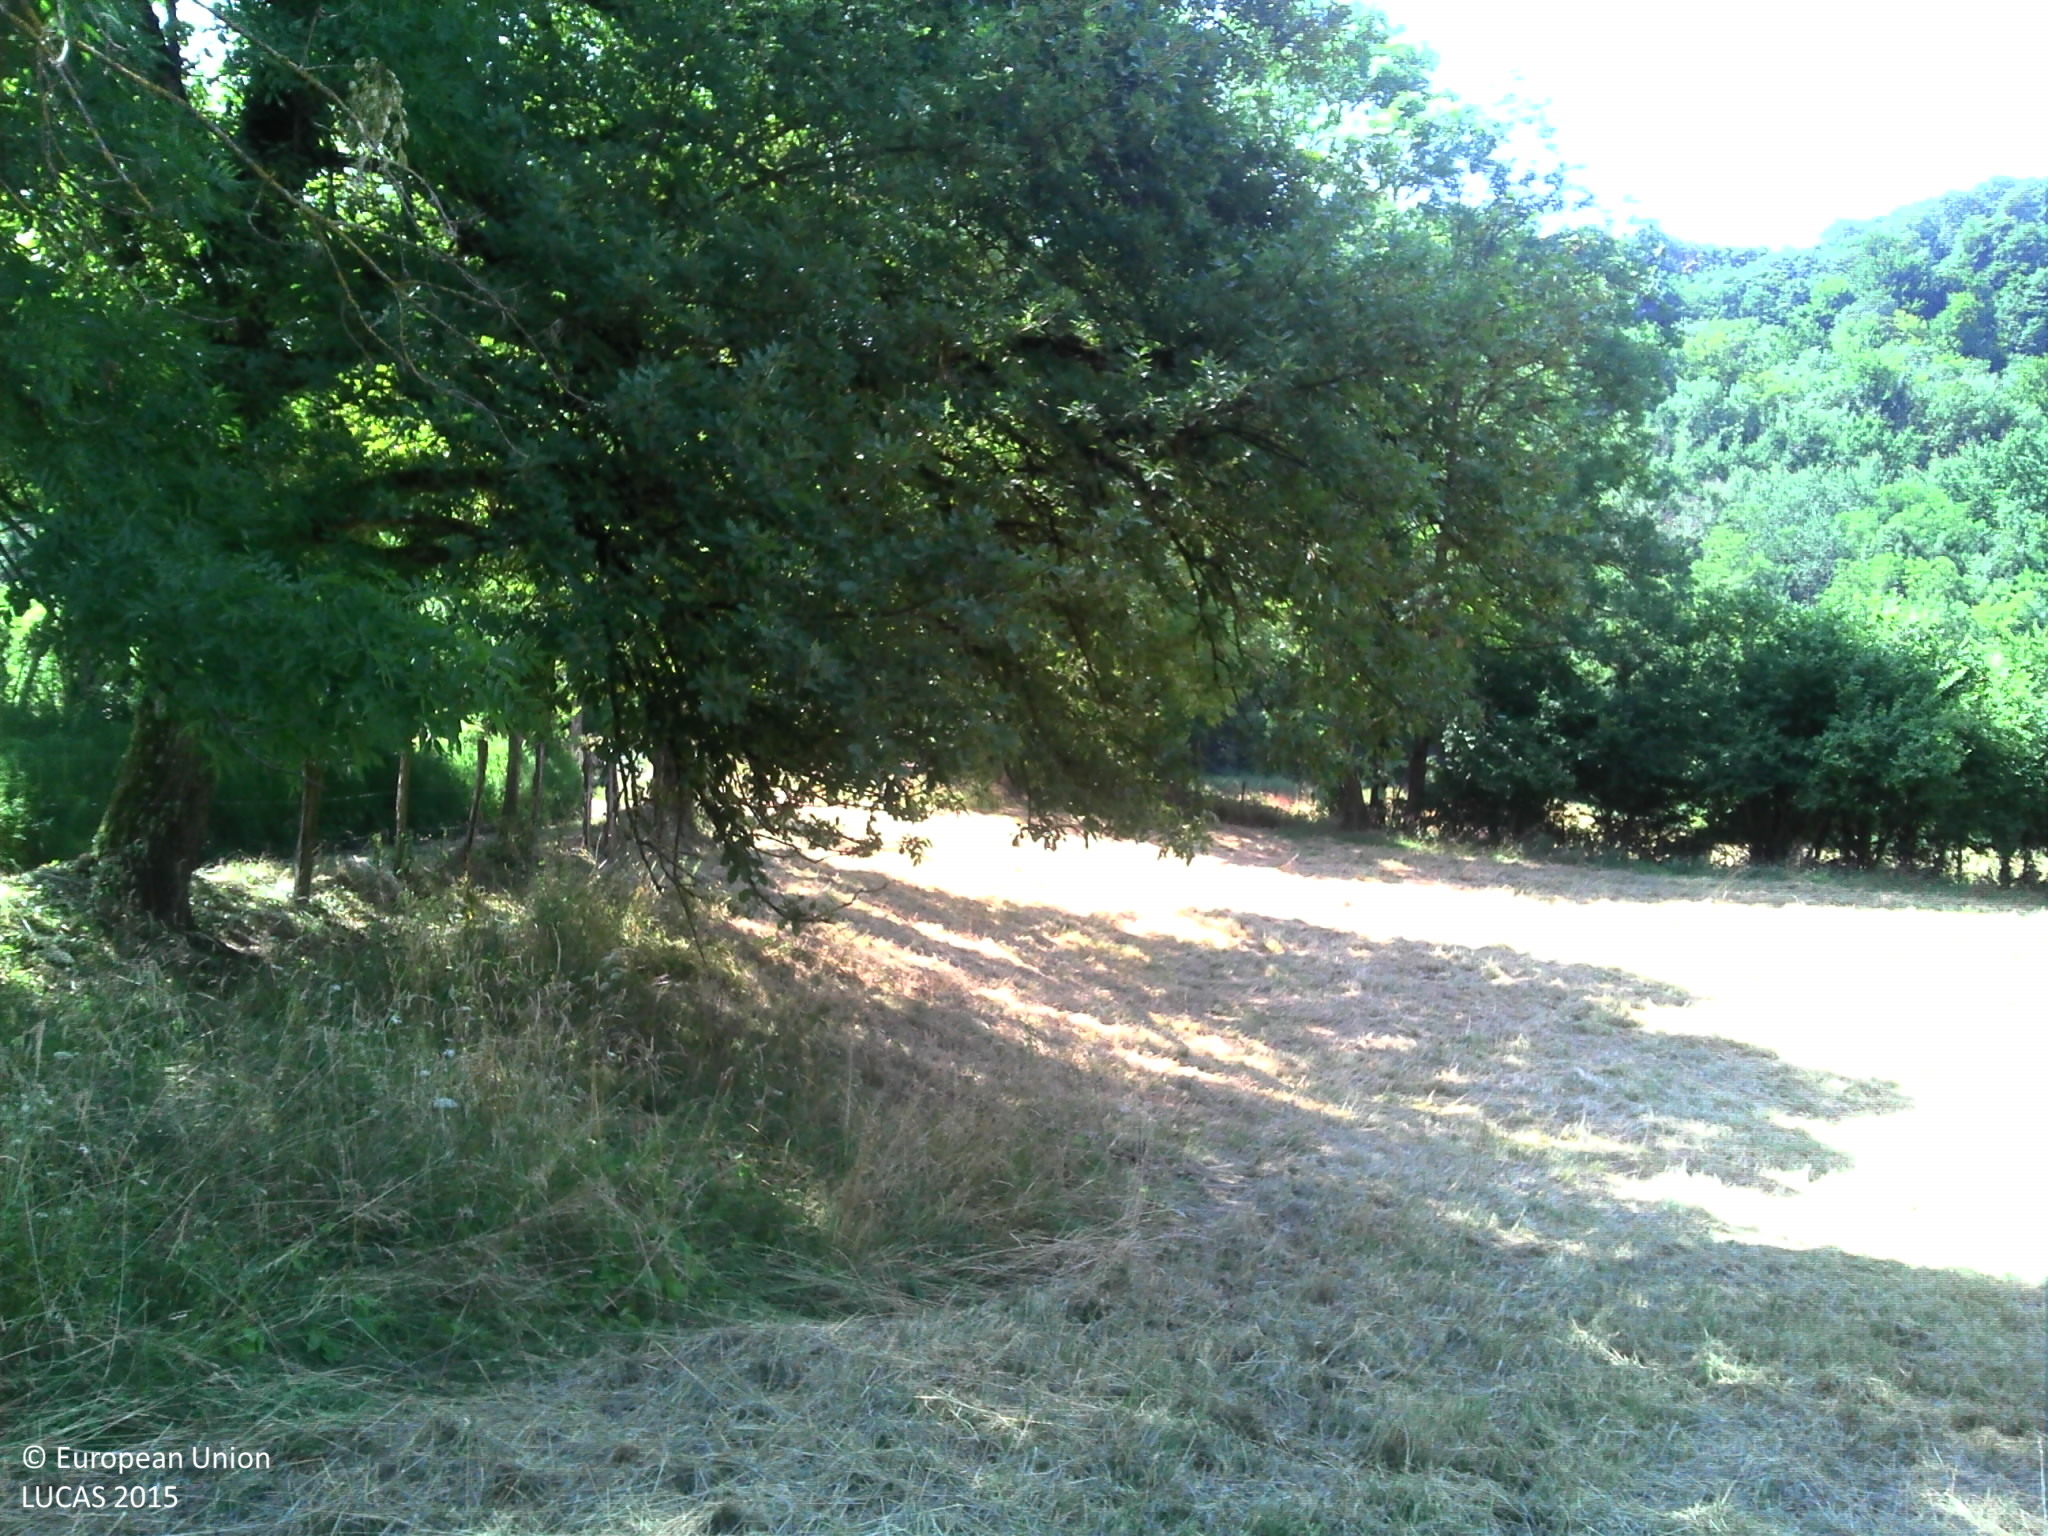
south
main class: Grassland
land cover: Grassland without tree/shrub cover
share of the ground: > 75 %
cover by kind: herbaceous plants 100 %
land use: Agriculture (excluding fallow land and kitchen gardens)
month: July
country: FR
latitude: 45.5455
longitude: 5.3296
